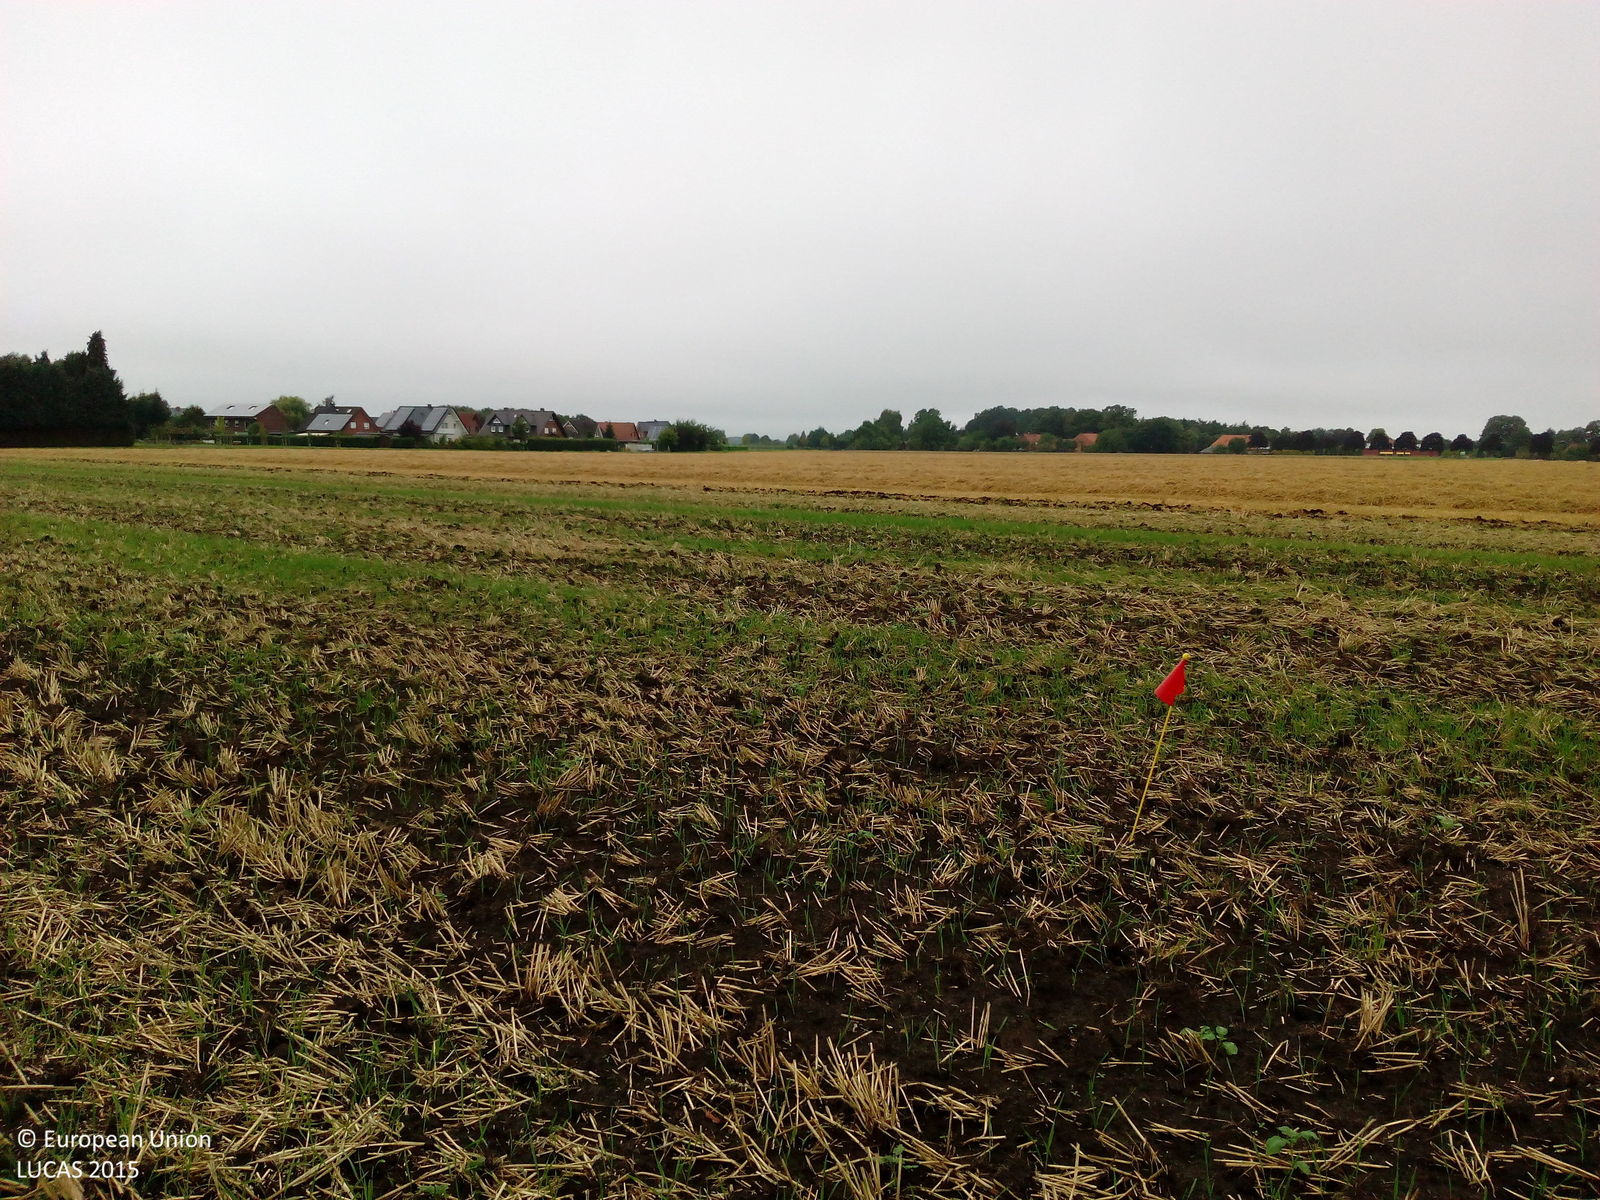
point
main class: Cropland
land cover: Common wheat
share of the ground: 25 - 50 %
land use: Agriculture (excluding fallow land and kitchen gardens)
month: August
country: DE
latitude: 52.8006
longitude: 8.5914
